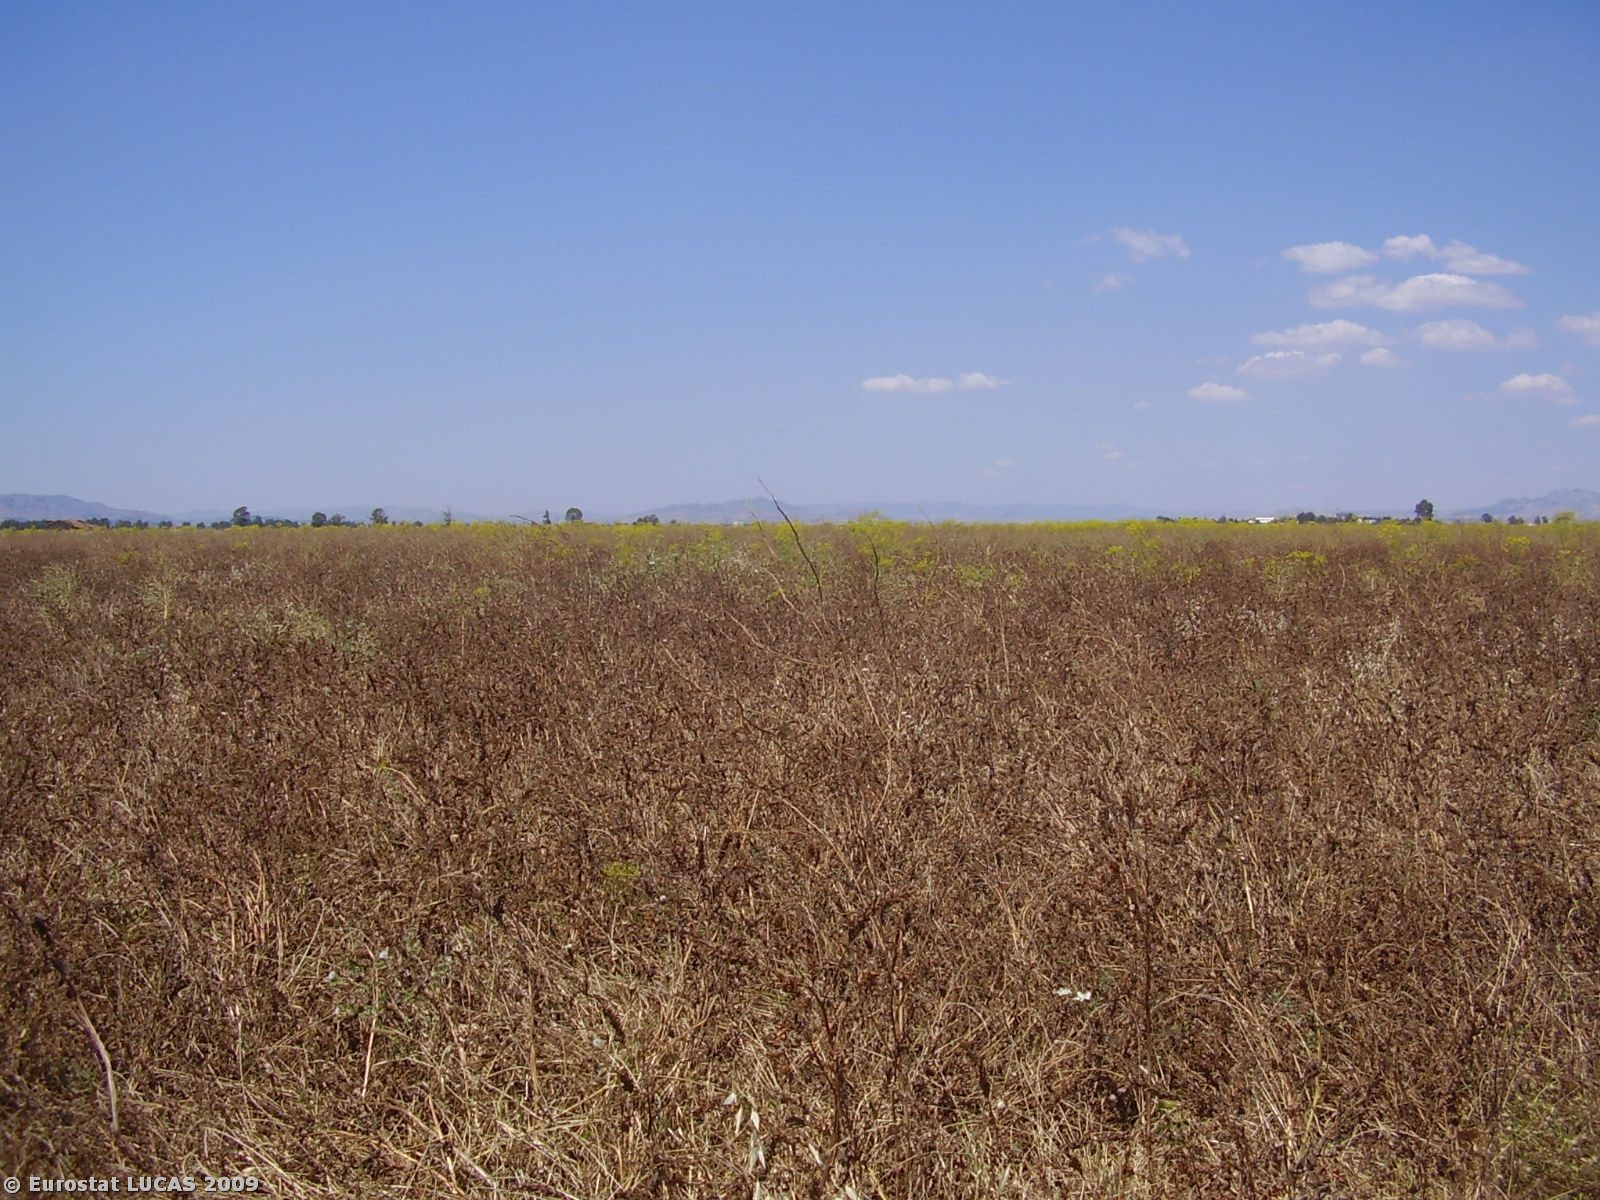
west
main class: Cropland
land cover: Other cereals
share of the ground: > 75 %
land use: Agriculture (excluding fallow land and kitchen gardens)
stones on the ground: < 10 %
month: June
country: IT
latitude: 37.3994
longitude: 14.9679
